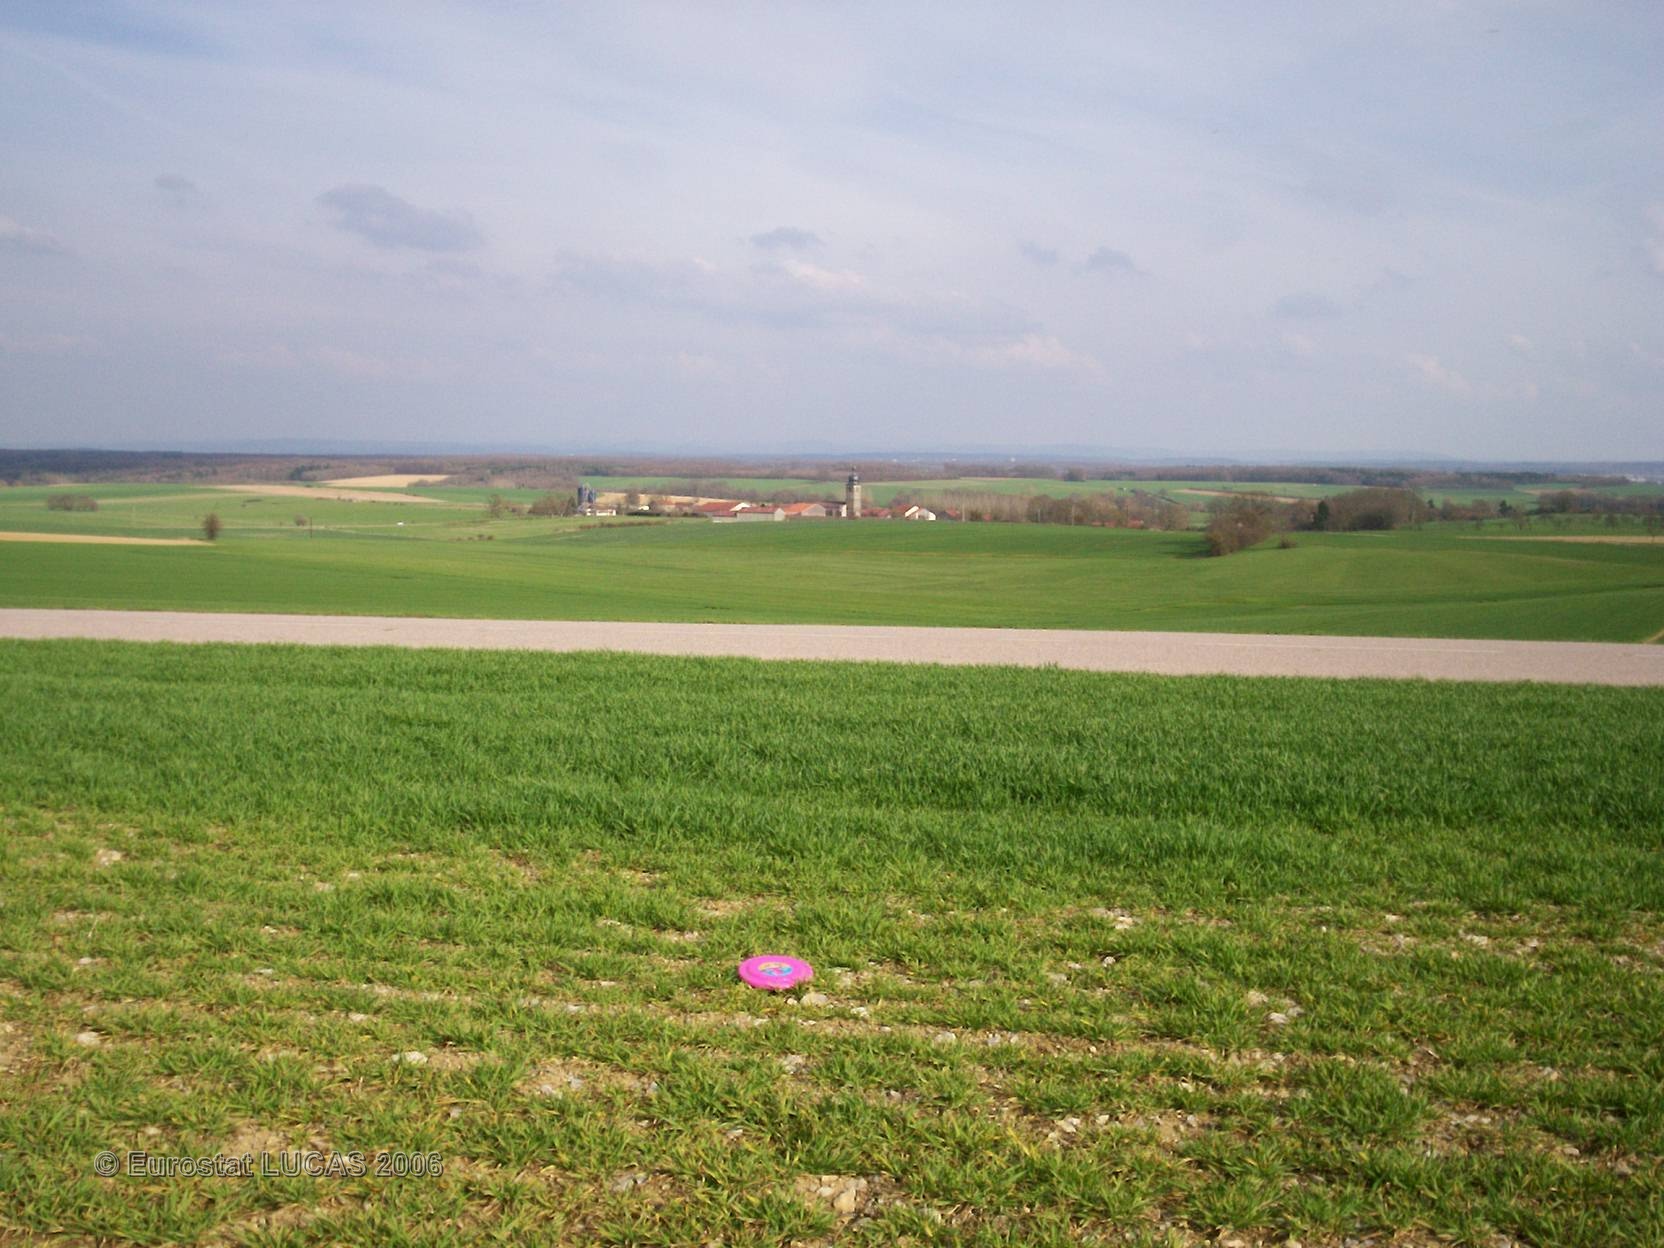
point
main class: Cropland
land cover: Common wheat
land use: Agriculture (excluding fallow land and kitchen gardens)
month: April
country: FR
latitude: 48.2344
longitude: 6.3250
